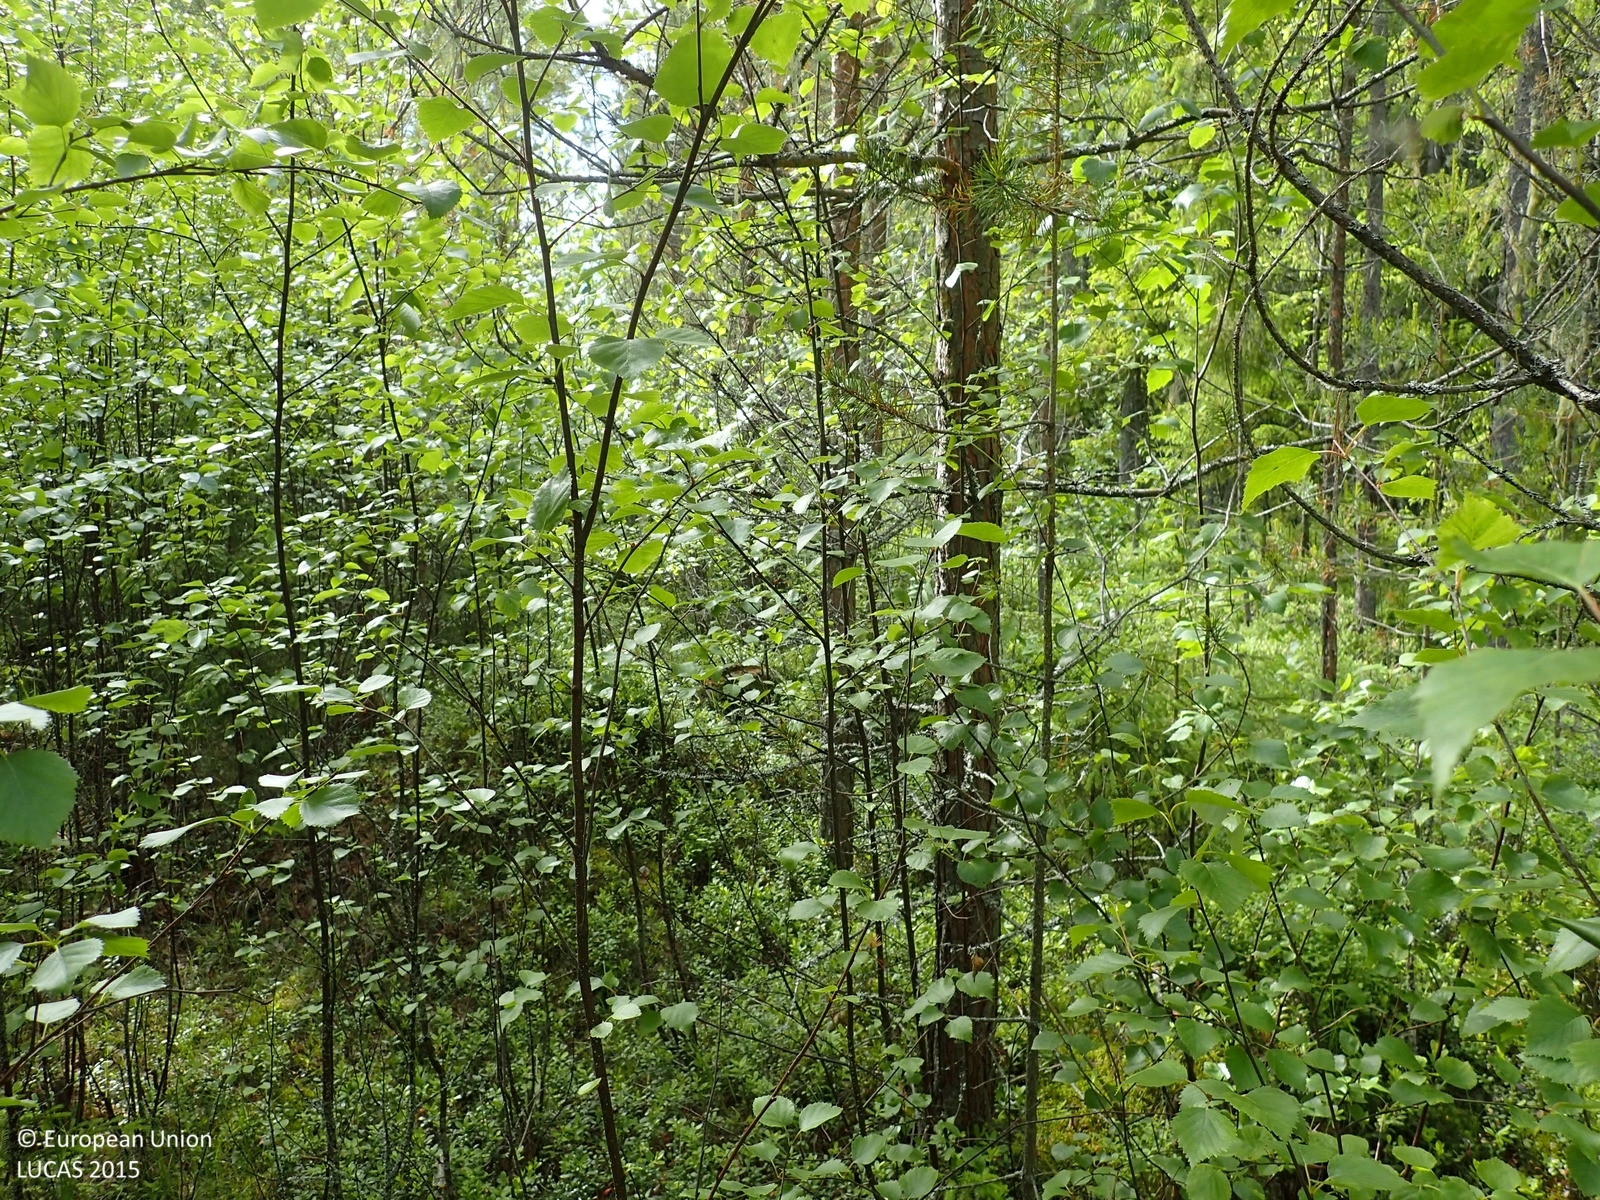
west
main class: Woodland
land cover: Pine dominated mixed woodland
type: boreal forest
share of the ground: > 75 %
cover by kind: coniferous forest trees 50 %, broadleaved forest trees 40 %, shrubs 10 %
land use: Forestry
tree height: < 5 m
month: June
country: FI
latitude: 62.4445
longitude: 21.4953
